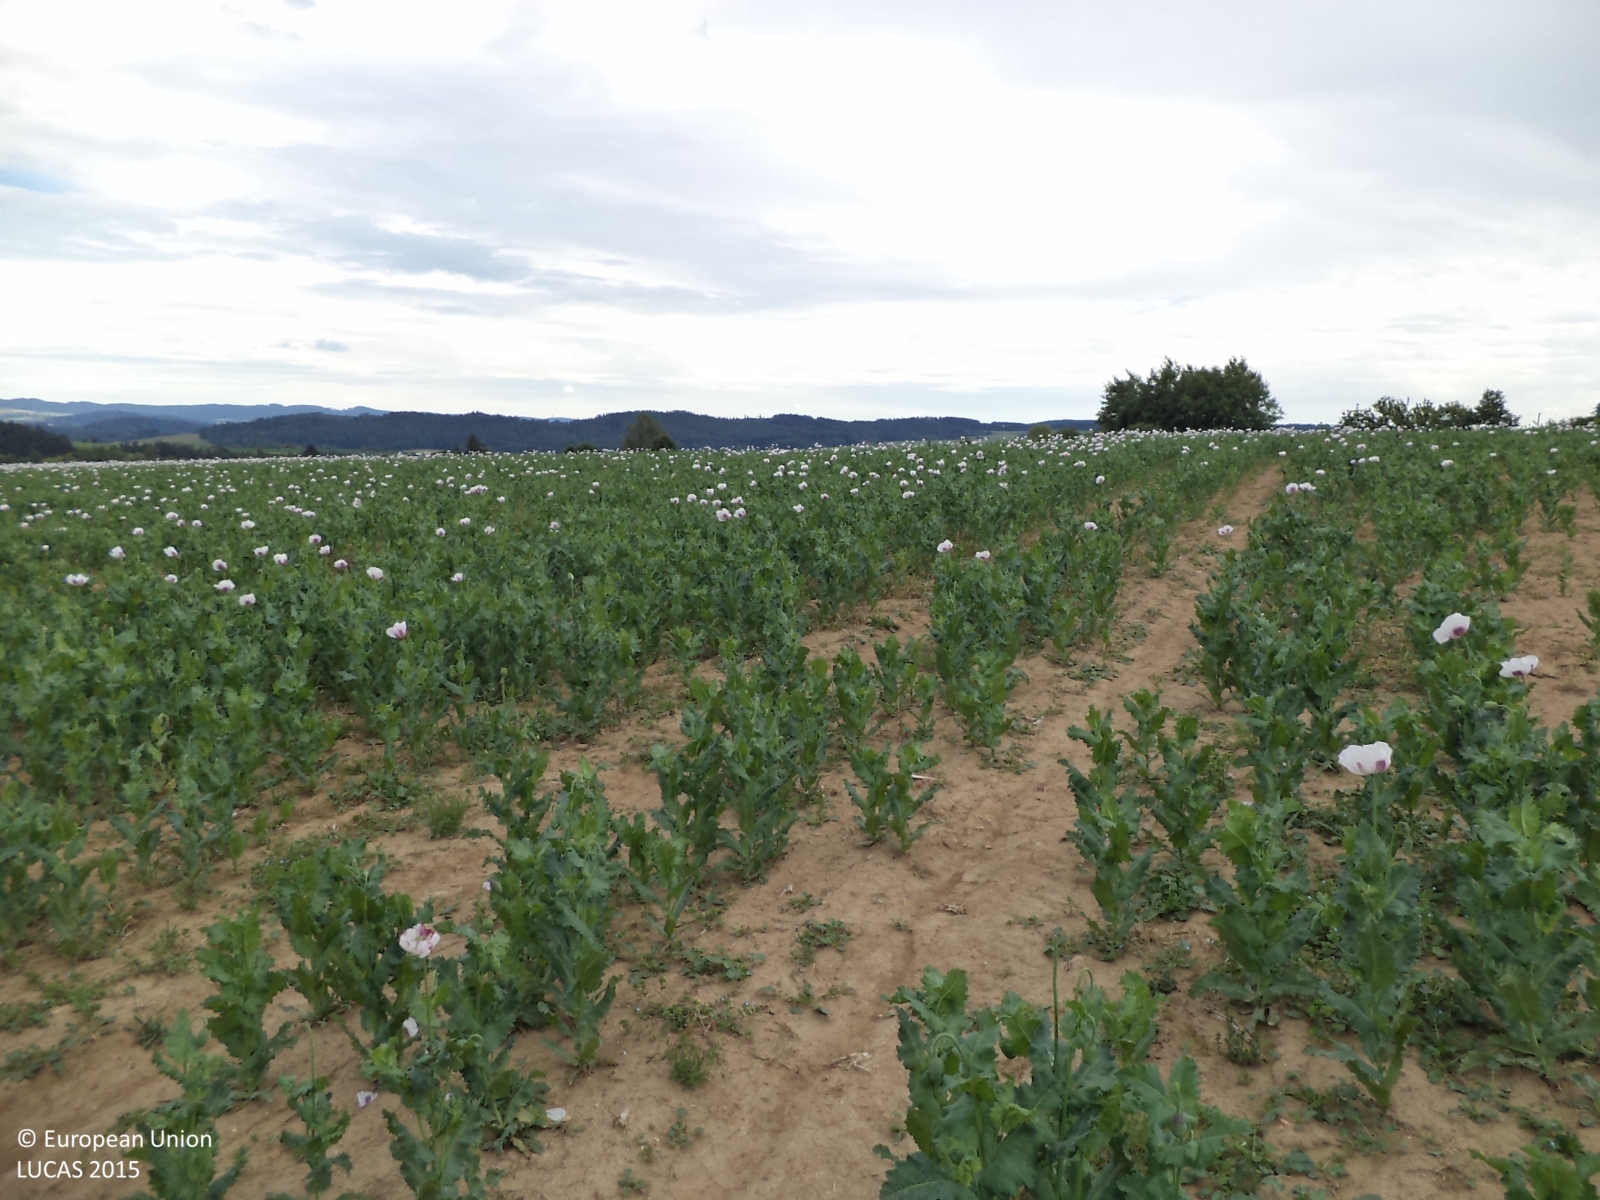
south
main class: Cropland
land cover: Other fibre and oleaginous crops
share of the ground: 50 - 75 %
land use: Agriculture (excluding fallow land and kitchen gardens)
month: June
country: CZ
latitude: 49.6505
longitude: 14.8083
